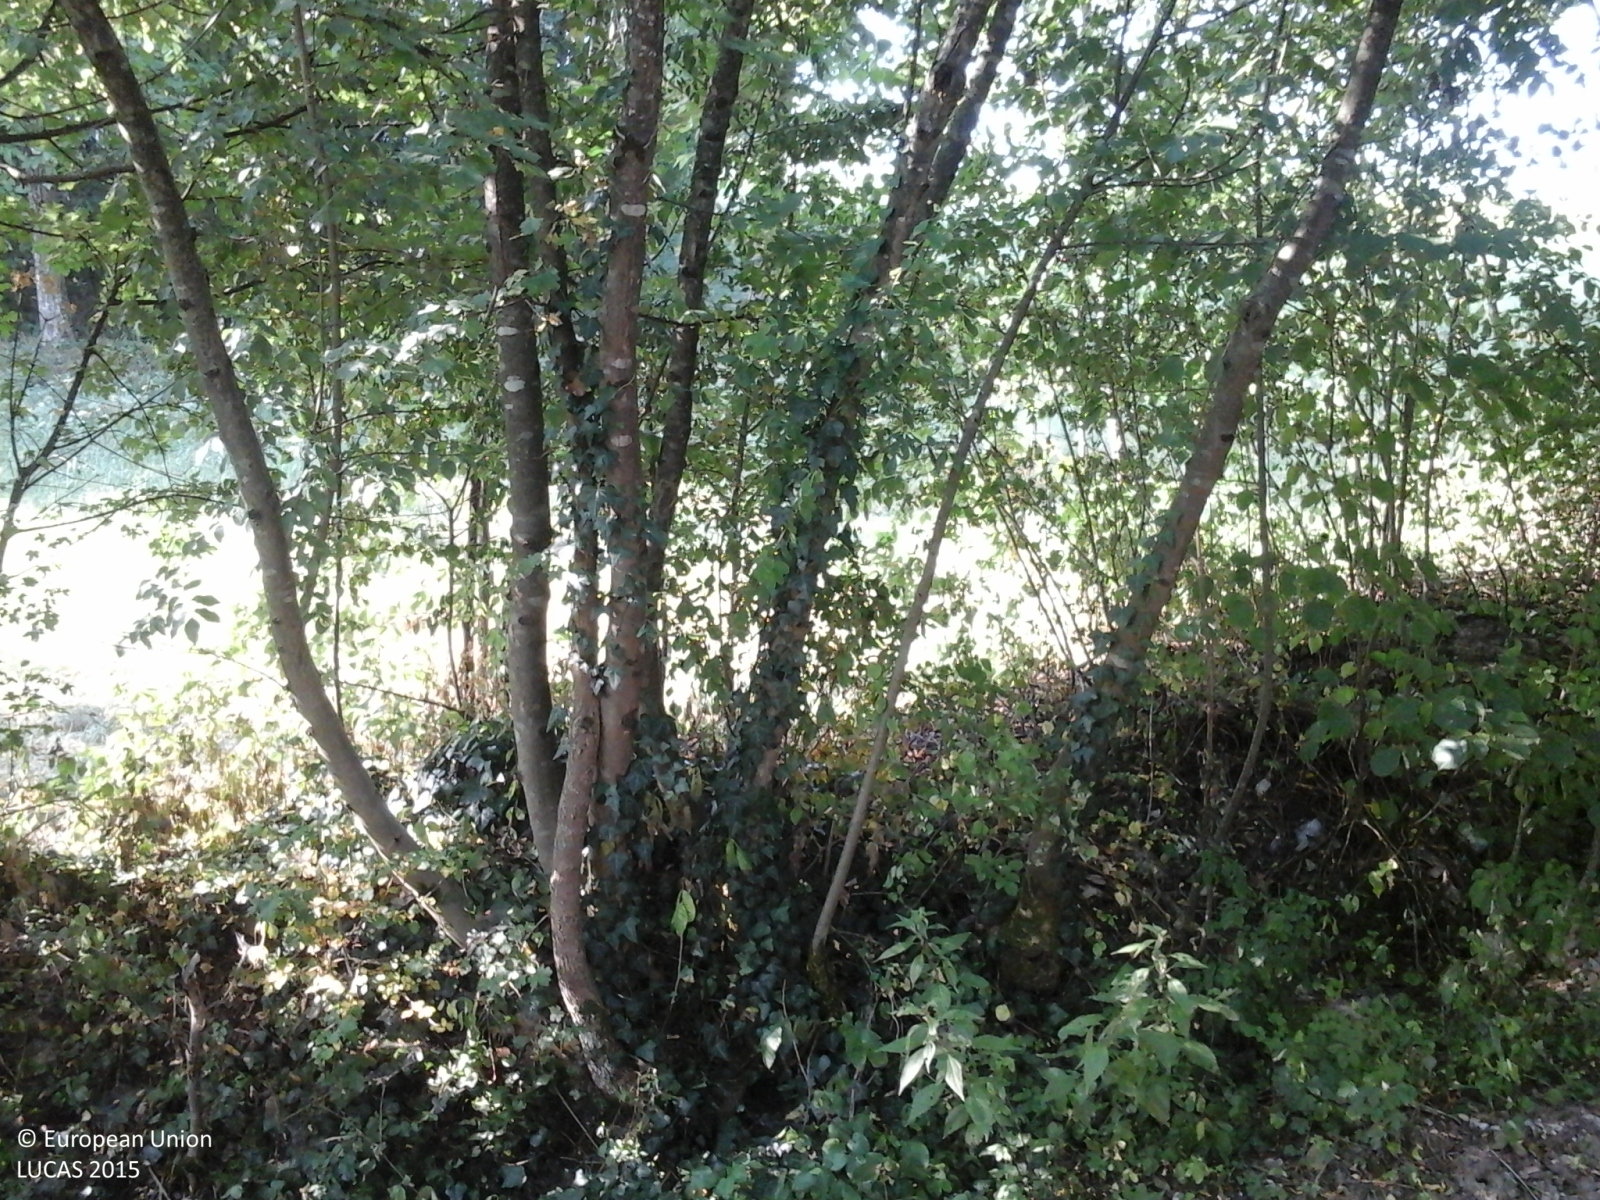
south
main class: Grassland
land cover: Grassland without tree/shrub cover
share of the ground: > 75 %
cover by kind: herbaceous plants 100 %
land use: Agriculture (excluding fallow land and kitchen gardens)
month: July
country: IT
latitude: 46.0271
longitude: 11.9481
